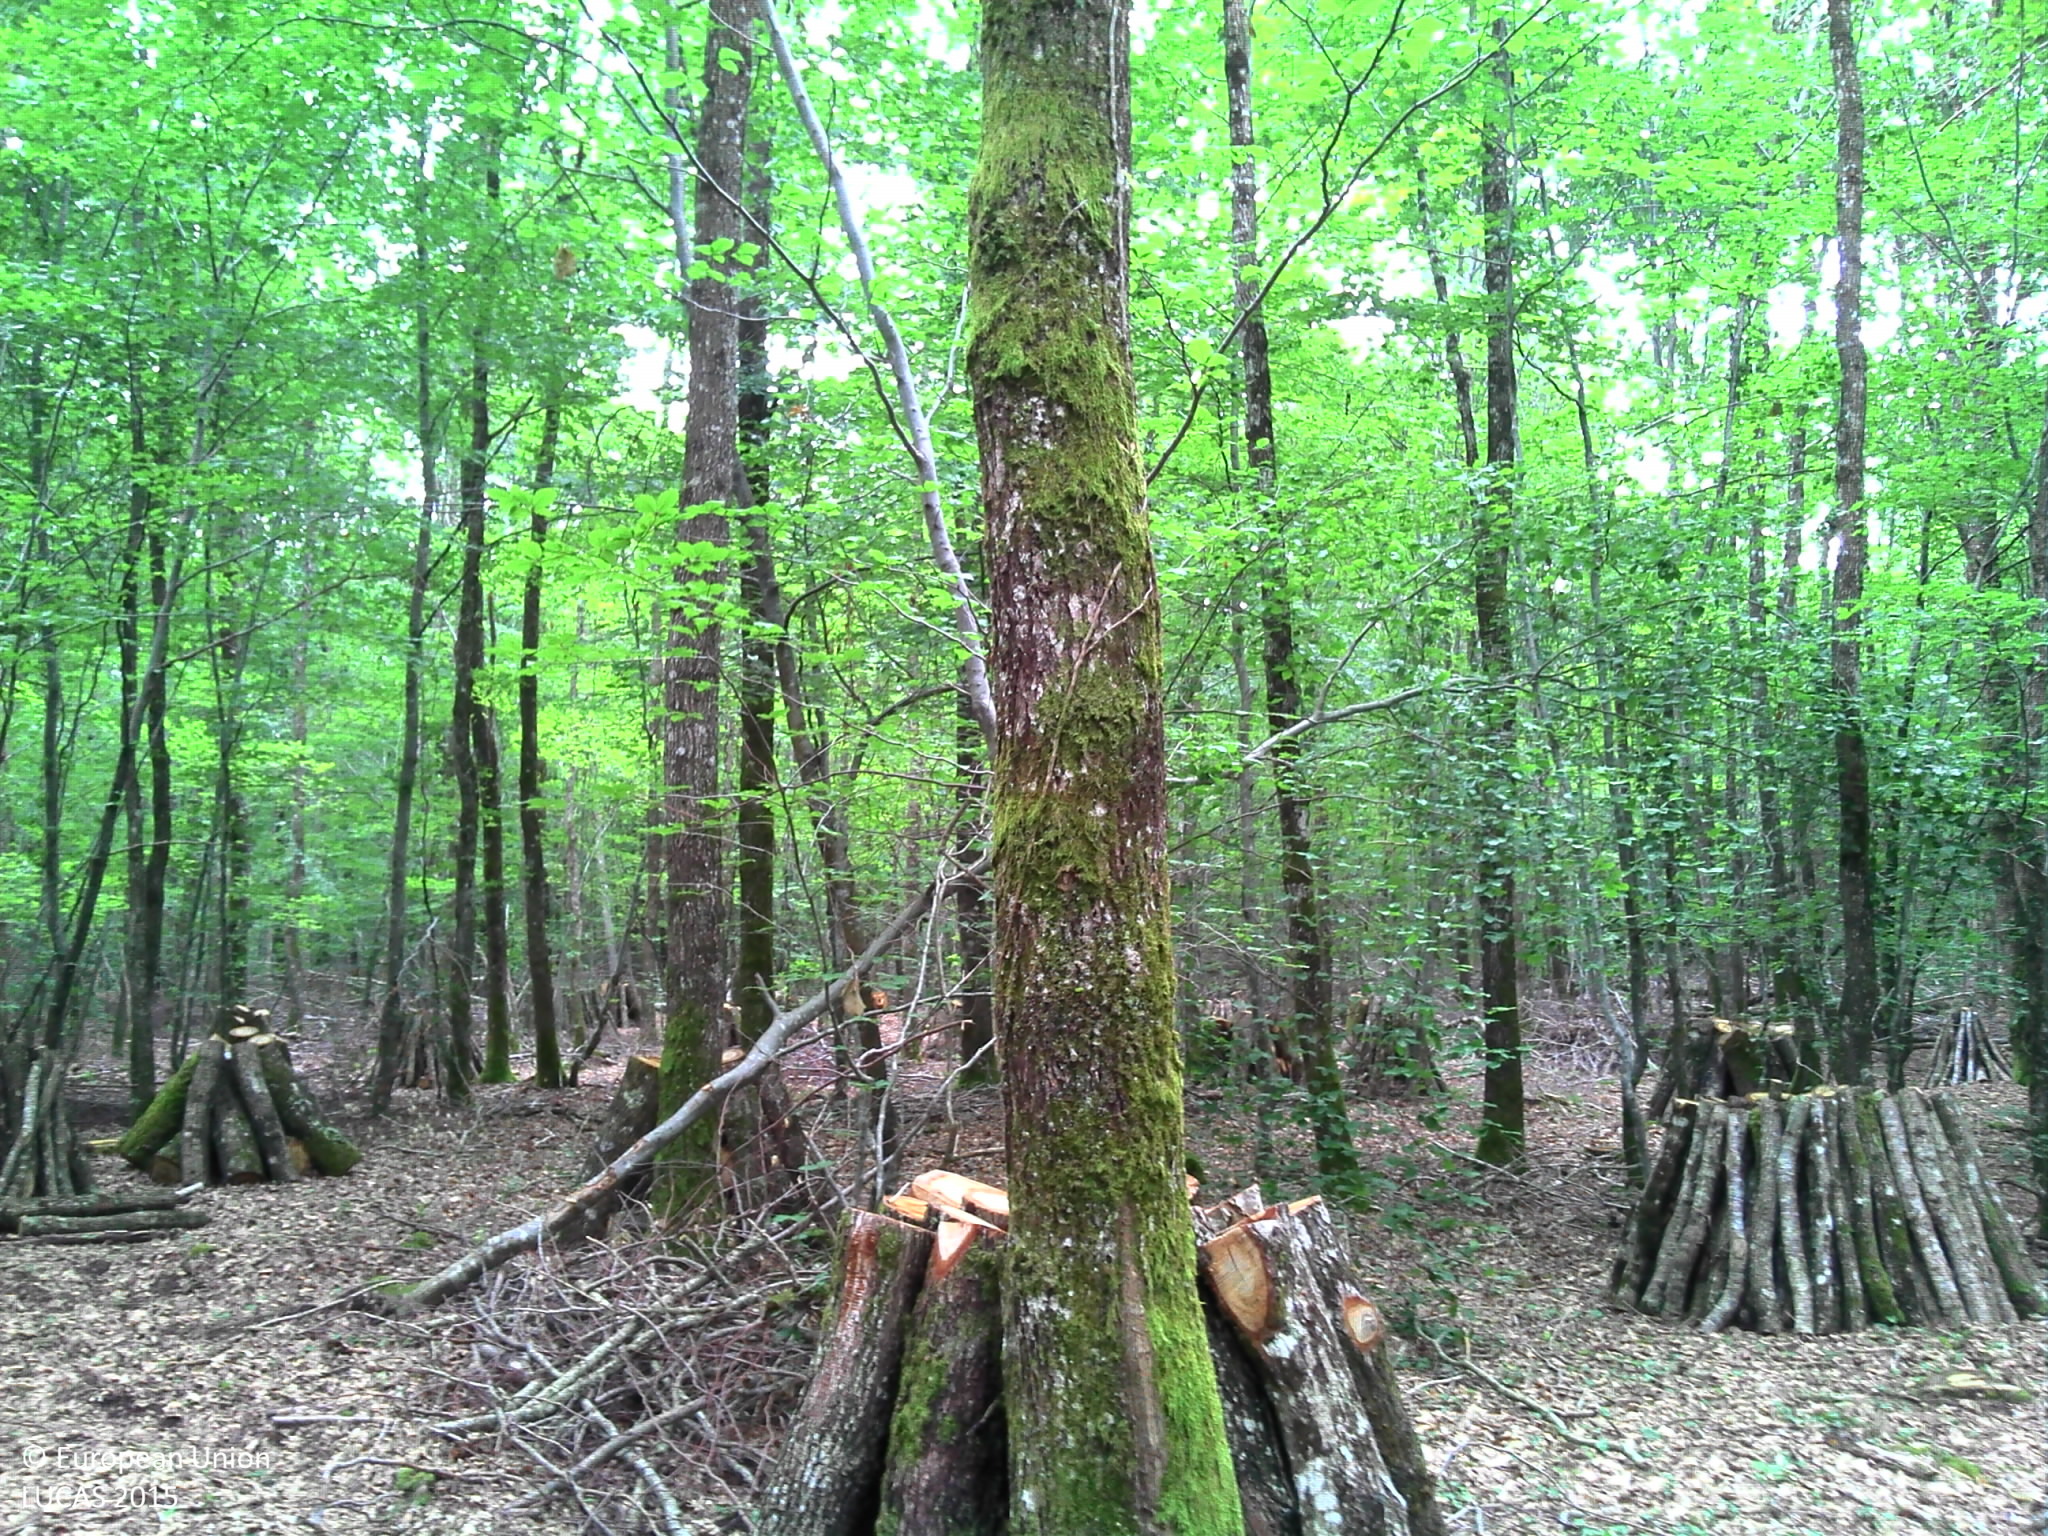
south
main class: Woodland
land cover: Broadleaved woodland
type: beech forest
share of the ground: > 75 %
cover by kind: broadleaved forest trees 90 %, herbaceous plants 5 %, unconsolidated bare surface 5 %
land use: Forestry
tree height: > 5 m
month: June
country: FR
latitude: 46.6273
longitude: 2.7208
